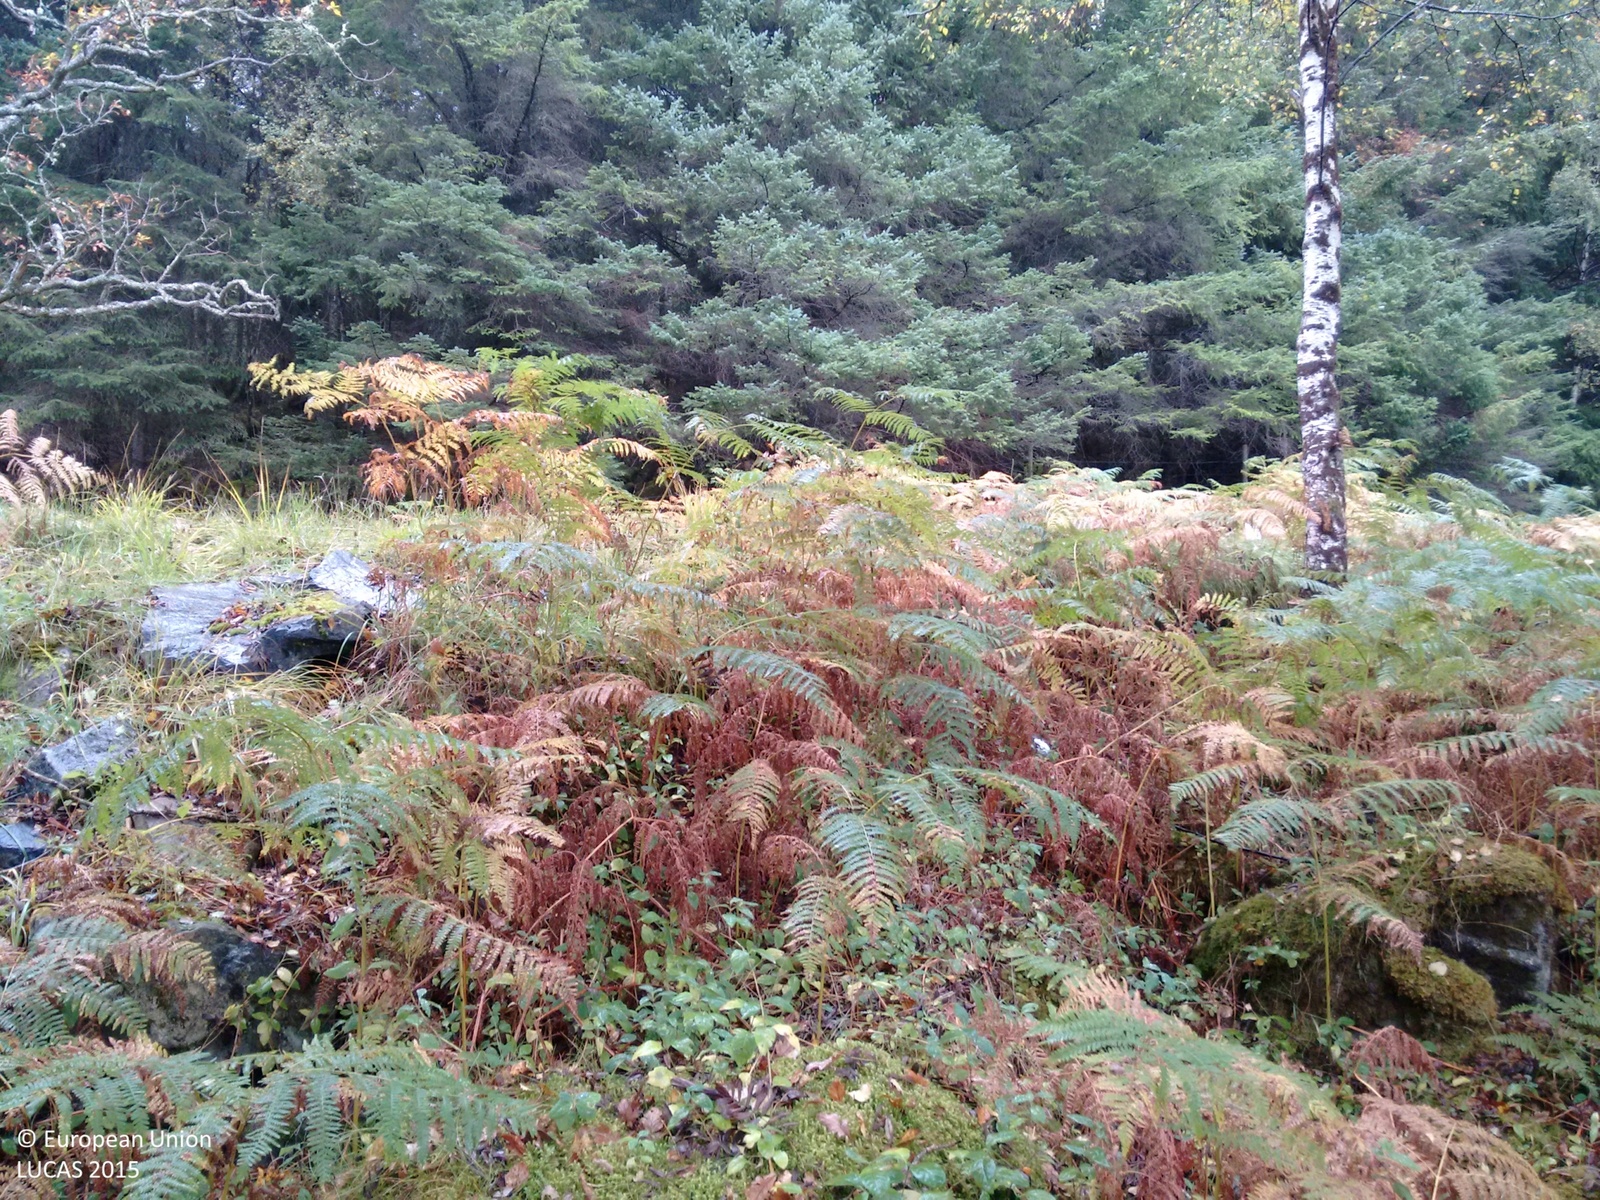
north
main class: Woodland
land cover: Broadleaved woodland
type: acidophilous oak and oak-birch forest
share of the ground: > 75 %
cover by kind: broadleaved forest trees 80 %, shrubs 10 %, herbaceous plants 10 %
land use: Forestry
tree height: > 5 m
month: October
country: GB
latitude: 56.6856
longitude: -5.8161
